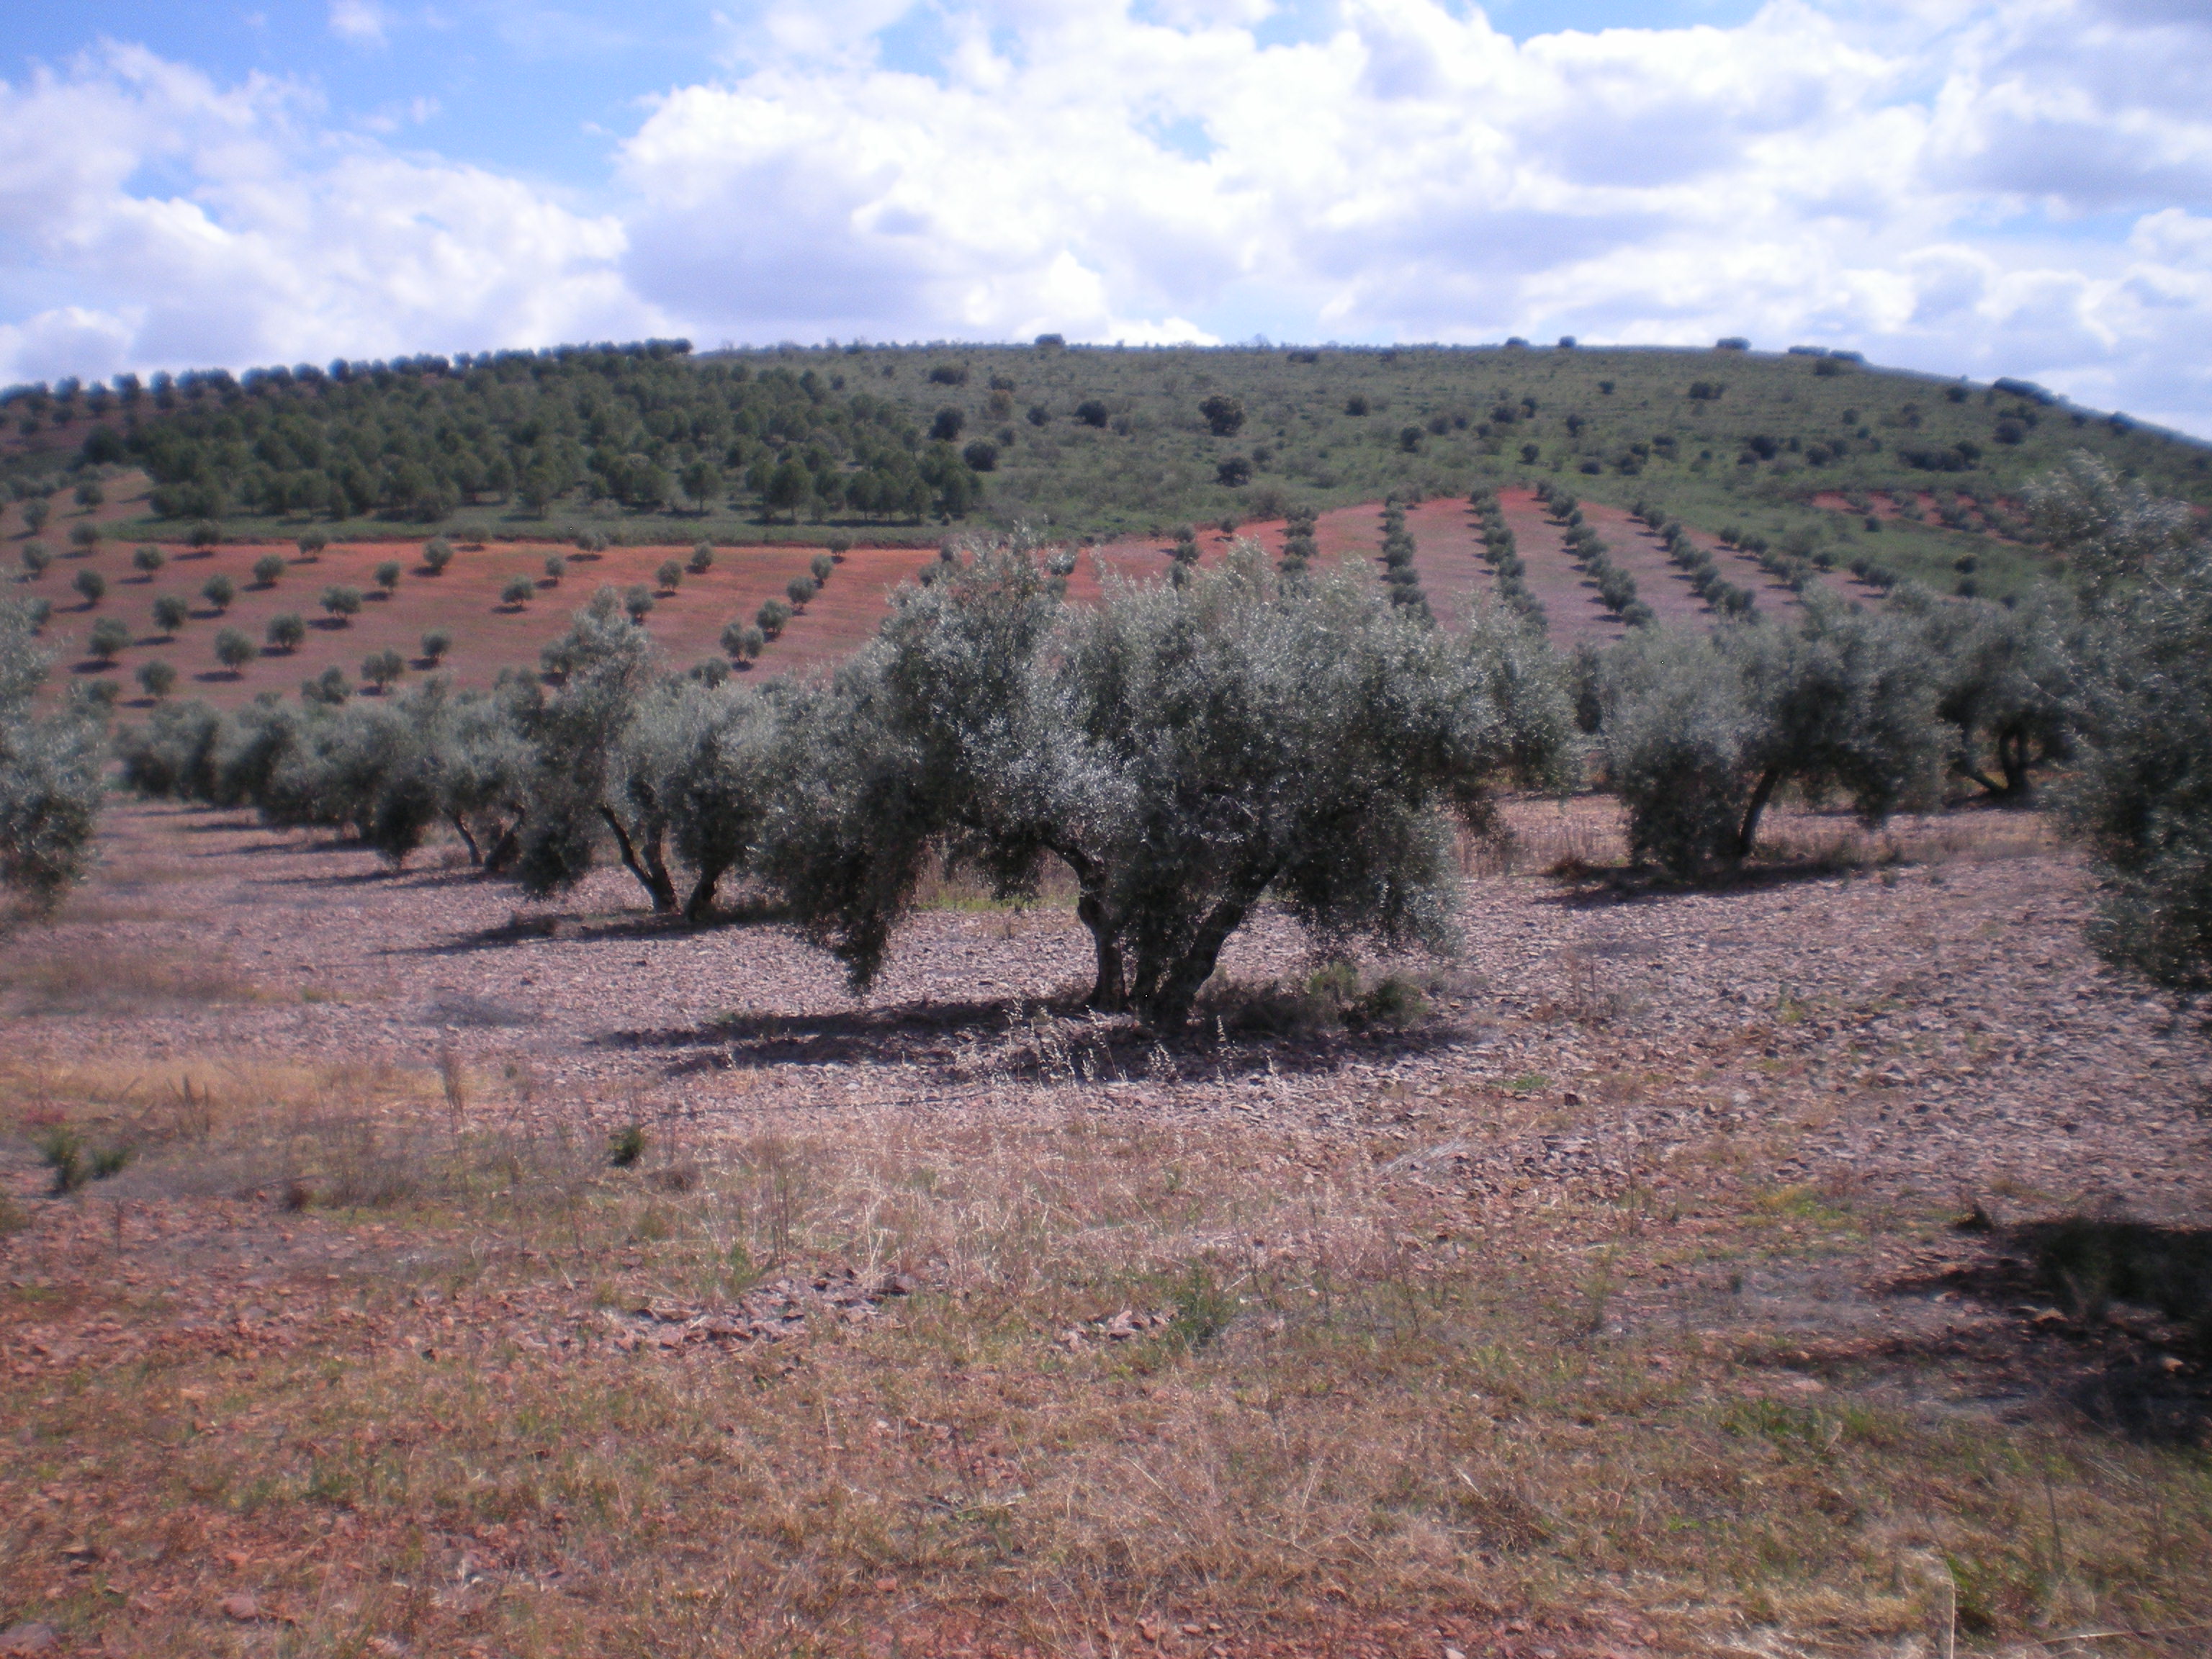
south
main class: Cropland
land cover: Olive groves
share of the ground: 25 - 50 %
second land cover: Other bare soil
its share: > 75 %
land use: Agriculture (excluding fallow land and kitchen gardens)
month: April
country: ES
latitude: 38.7567
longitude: -3.5337
